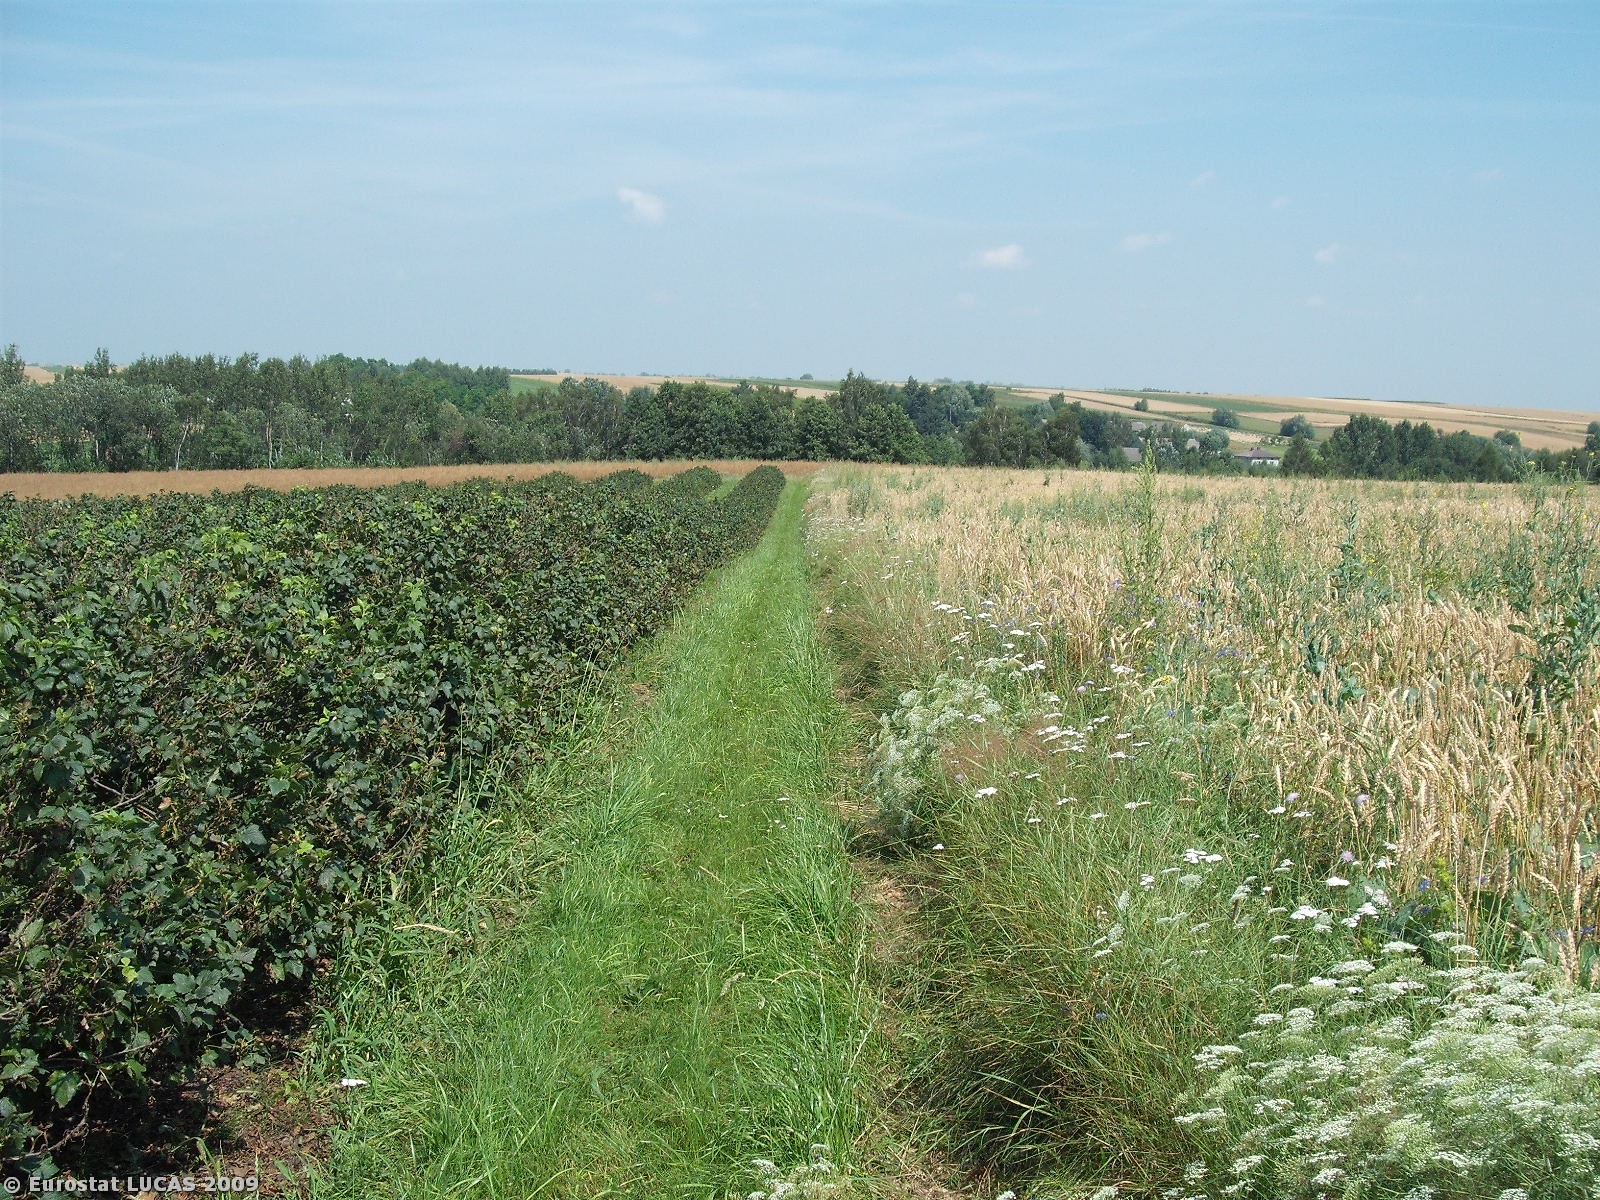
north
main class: Cropland
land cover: Common wheat
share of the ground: > 75 %
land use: Agriculture (excluding fallow land and kitchen gardens)
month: July
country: PL
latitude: 50.8391
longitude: 21.2806
